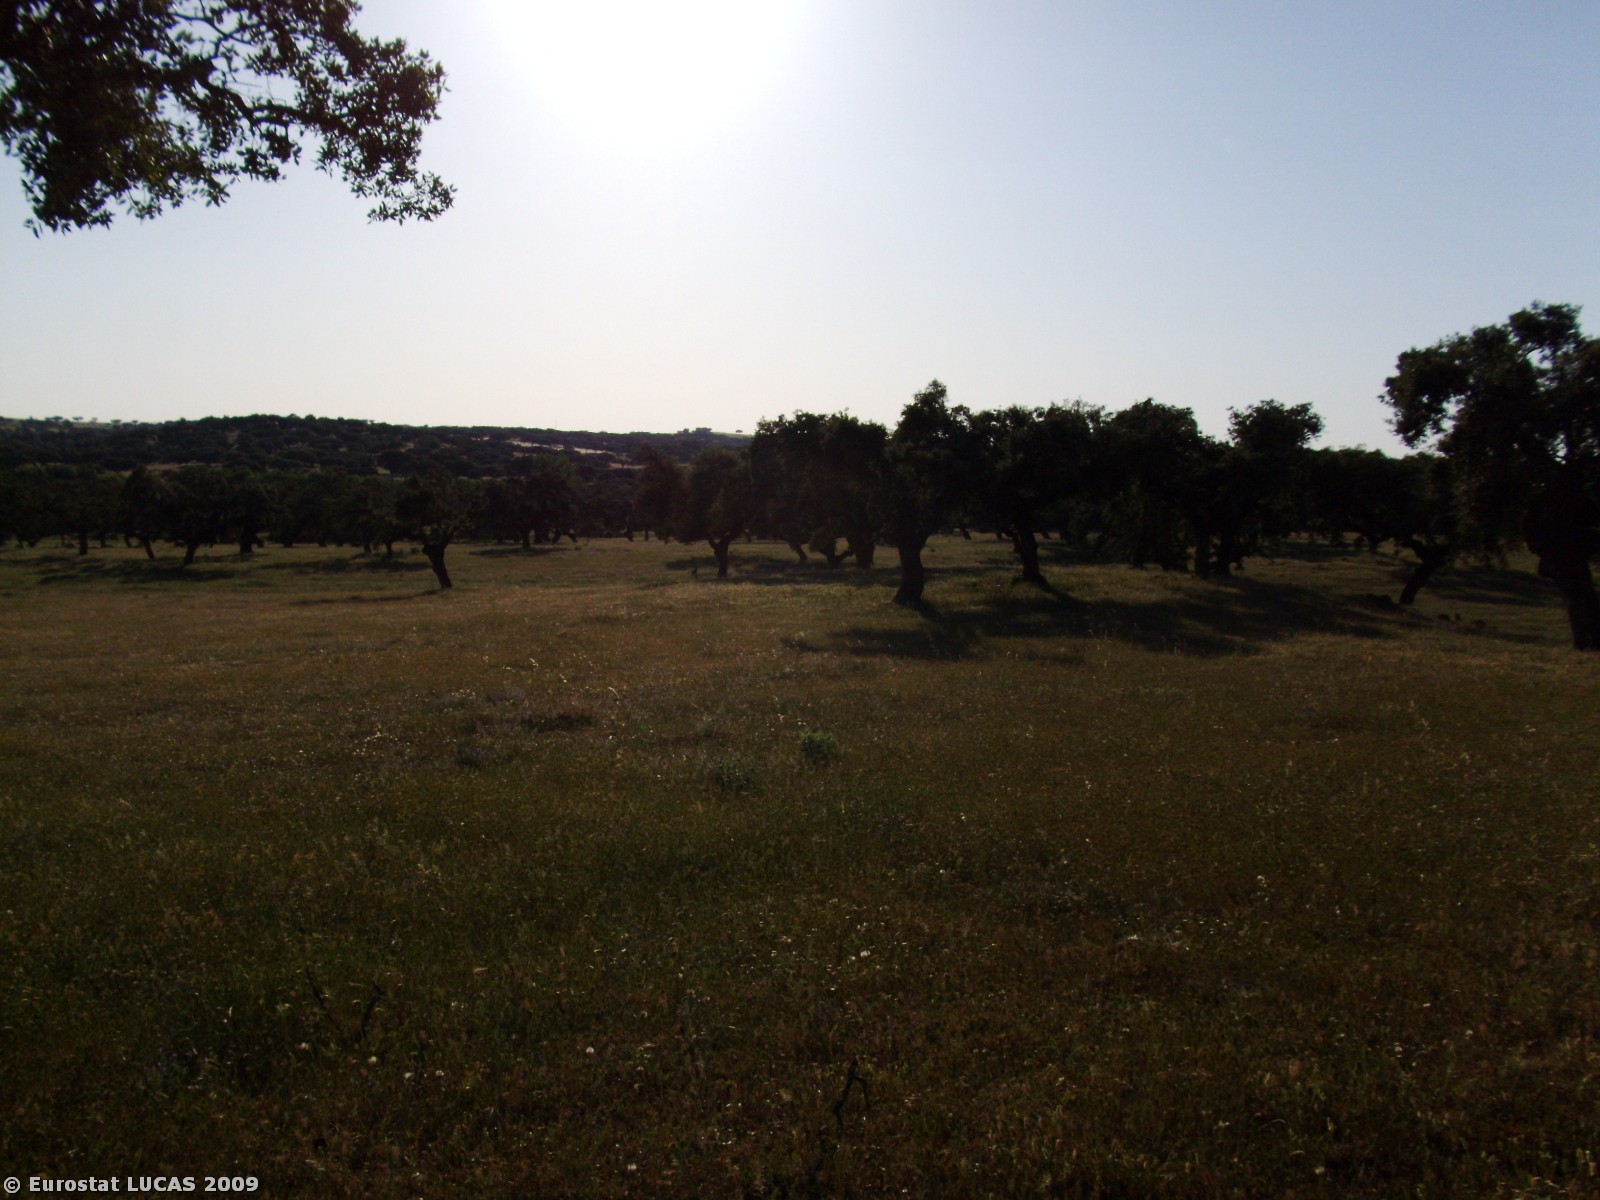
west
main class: Woodland
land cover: Broadleaved woodland
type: broadleaved evergreen forest
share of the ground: 10 - 25 %
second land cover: Spontaneously vegetated surfaces
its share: 25 - 50 %
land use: Agriculture (excluding fallow land and kitchen gardens)
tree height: > 5 m
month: May
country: PT
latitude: 38.7933
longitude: -7.2875
